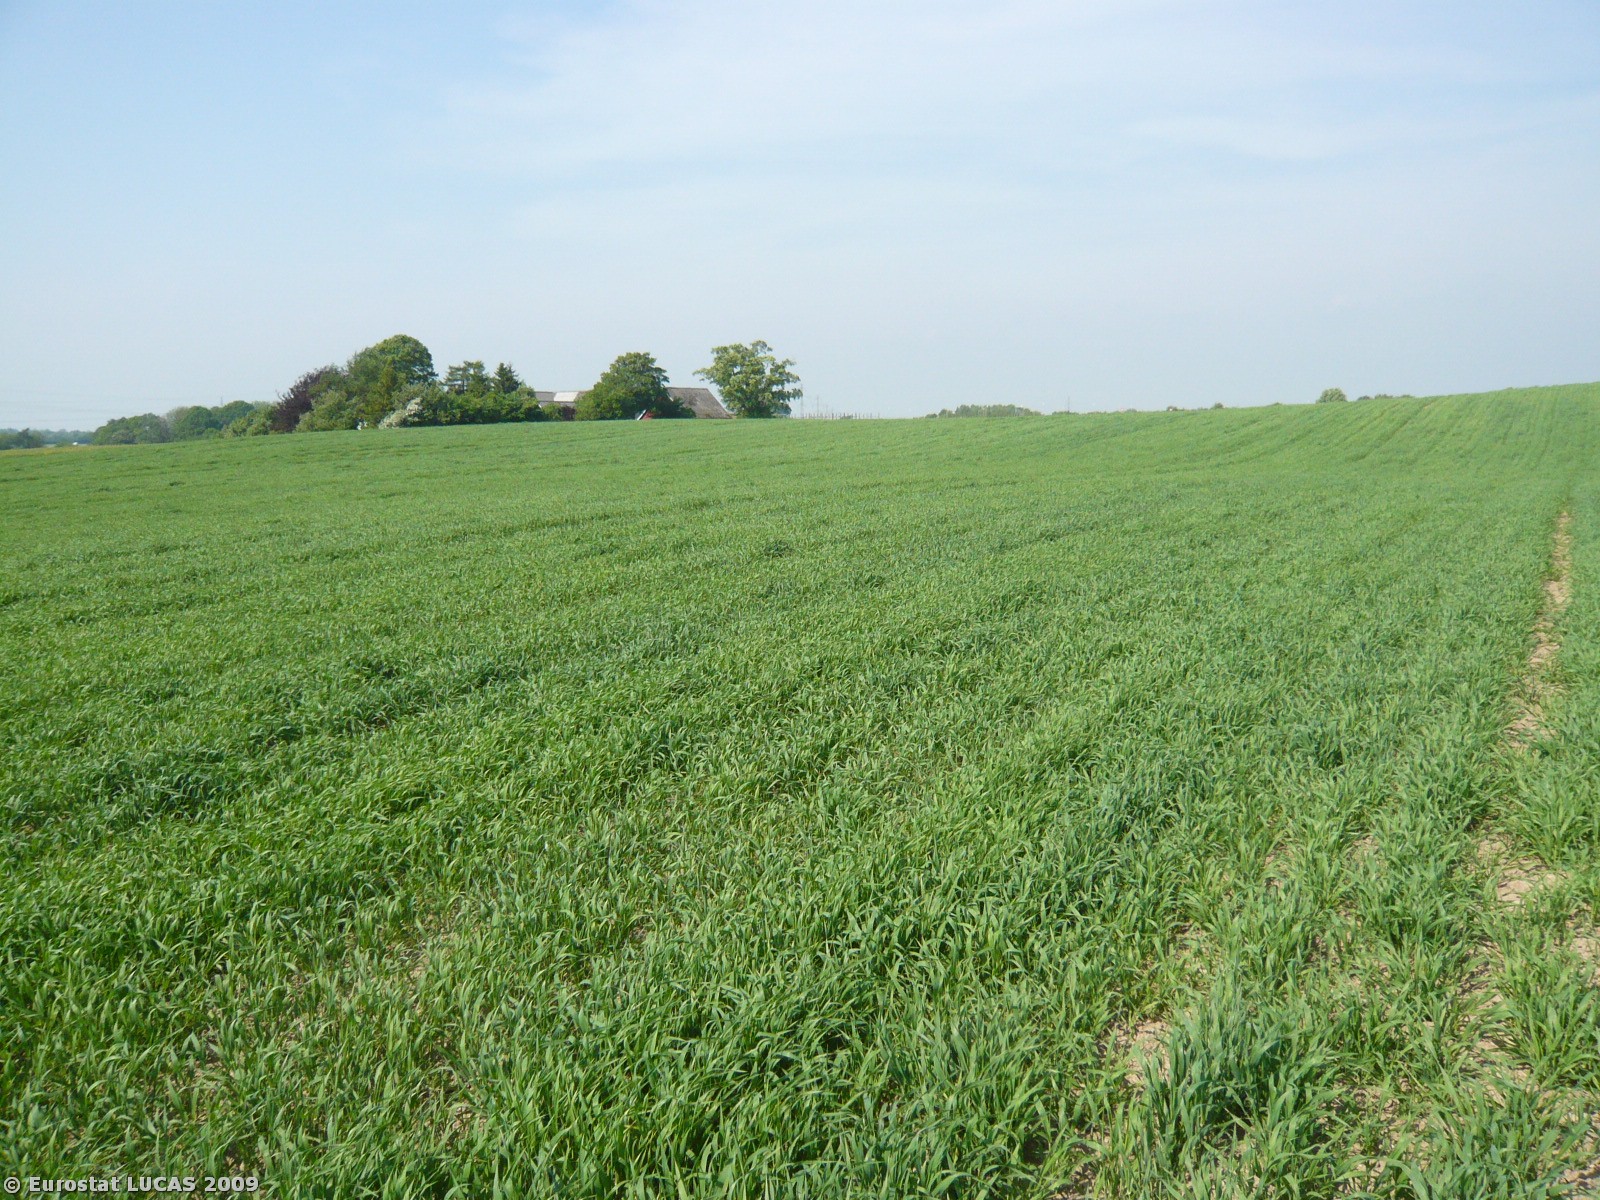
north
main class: Cropland
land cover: Barley
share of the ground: > 75 %
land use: Agriculture (excluding fallow land and kitchen gardens)
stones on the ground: < 10 %
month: May
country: DK
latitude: 55.2414
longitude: 11.7130
